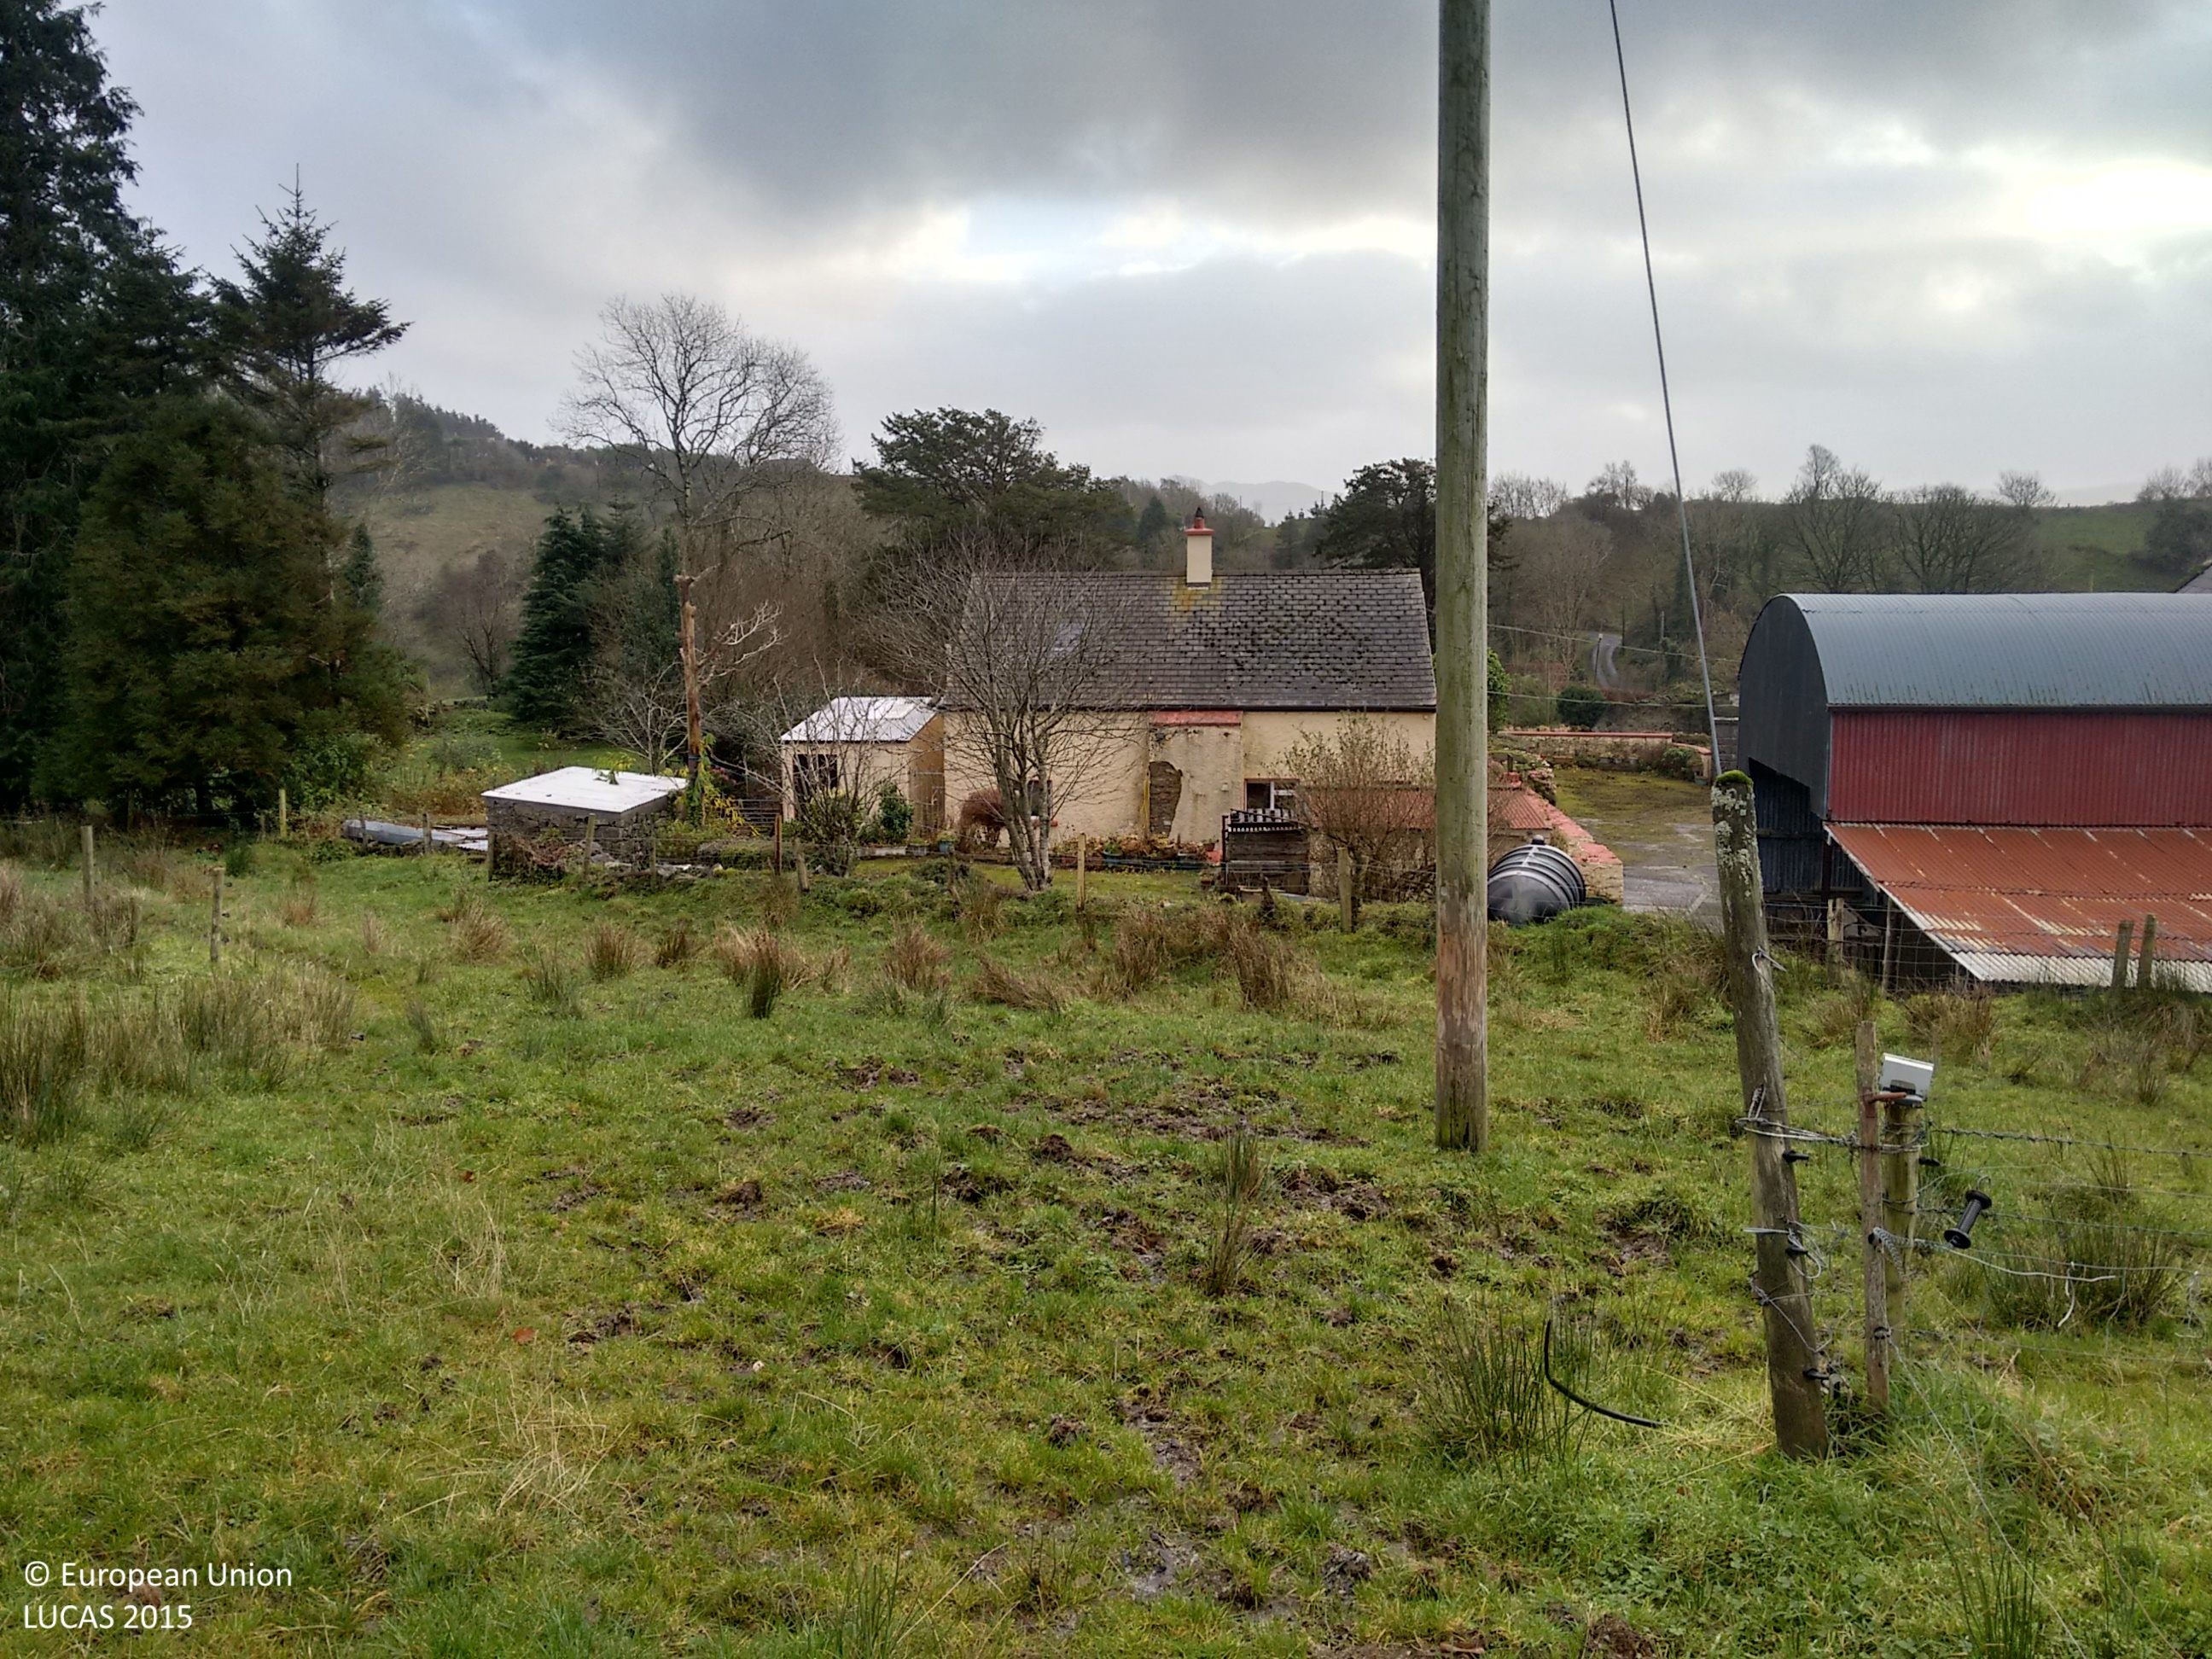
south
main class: Grassland
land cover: Grassland without tree/shrub cover
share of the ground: > 75 %
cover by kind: herbaceous plants 100 %
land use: Agriculture (excluding fallow land and kitchen gardens)
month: November
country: IE
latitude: 54.2852
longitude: -8.3903
